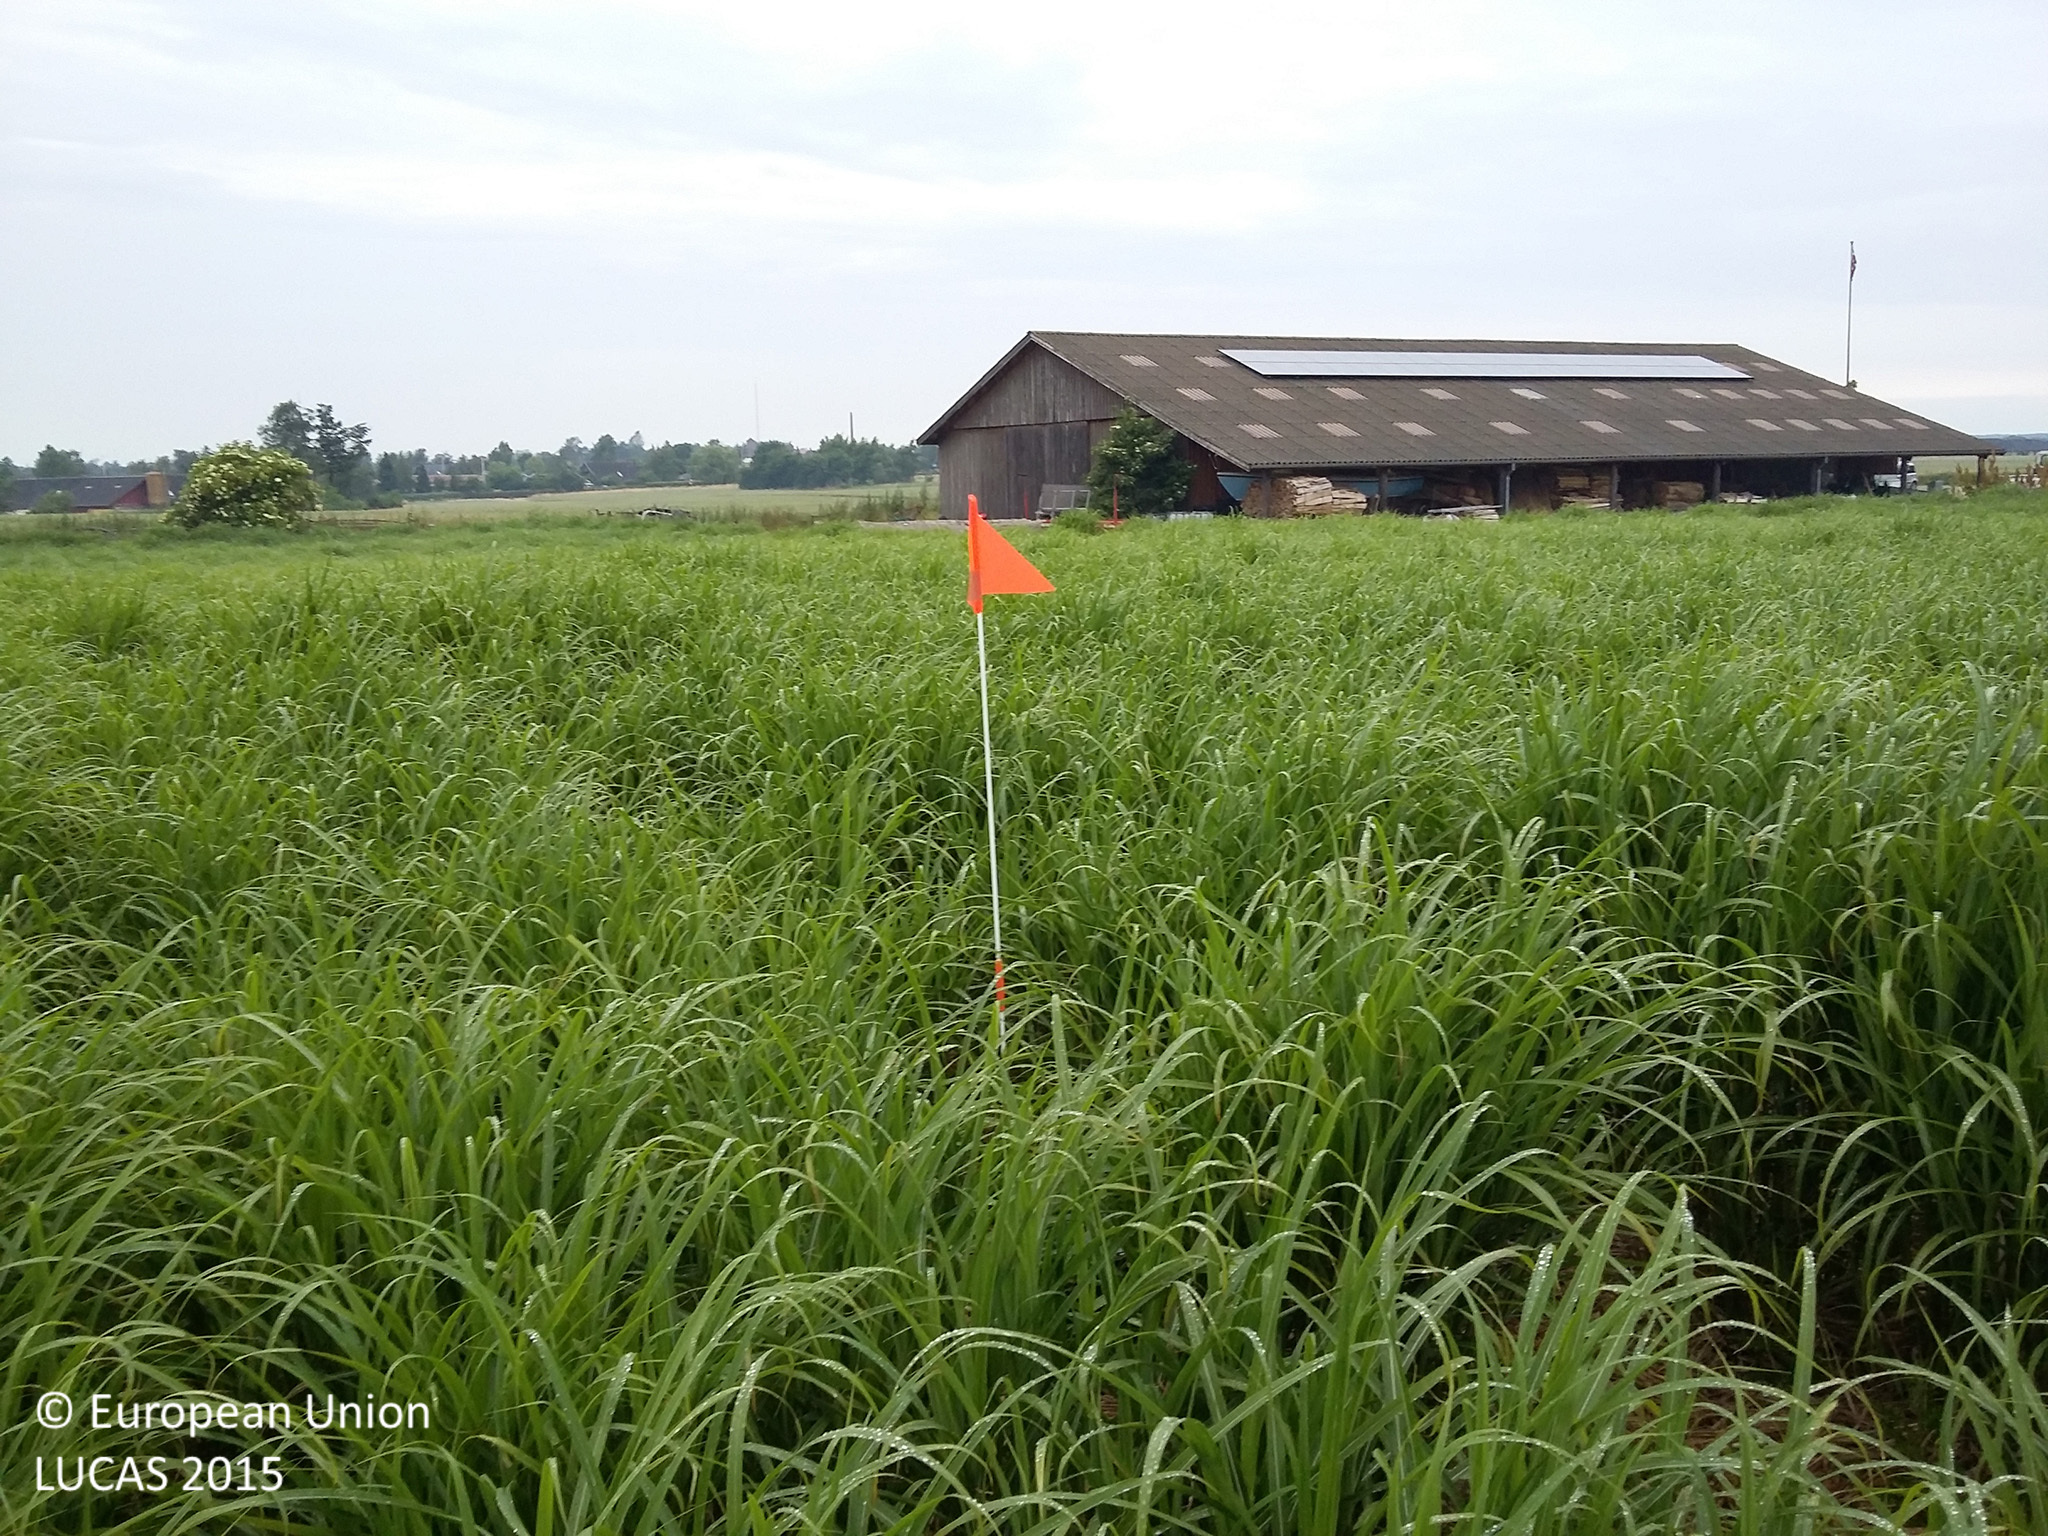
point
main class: Cropland
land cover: Permanent industrial crops
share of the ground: > 75 %
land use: Agriculture (excluding fallow land and kitchen gardens)
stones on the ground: < 10 %
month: July
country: DK
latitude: 55.2974
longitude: 11.5580
